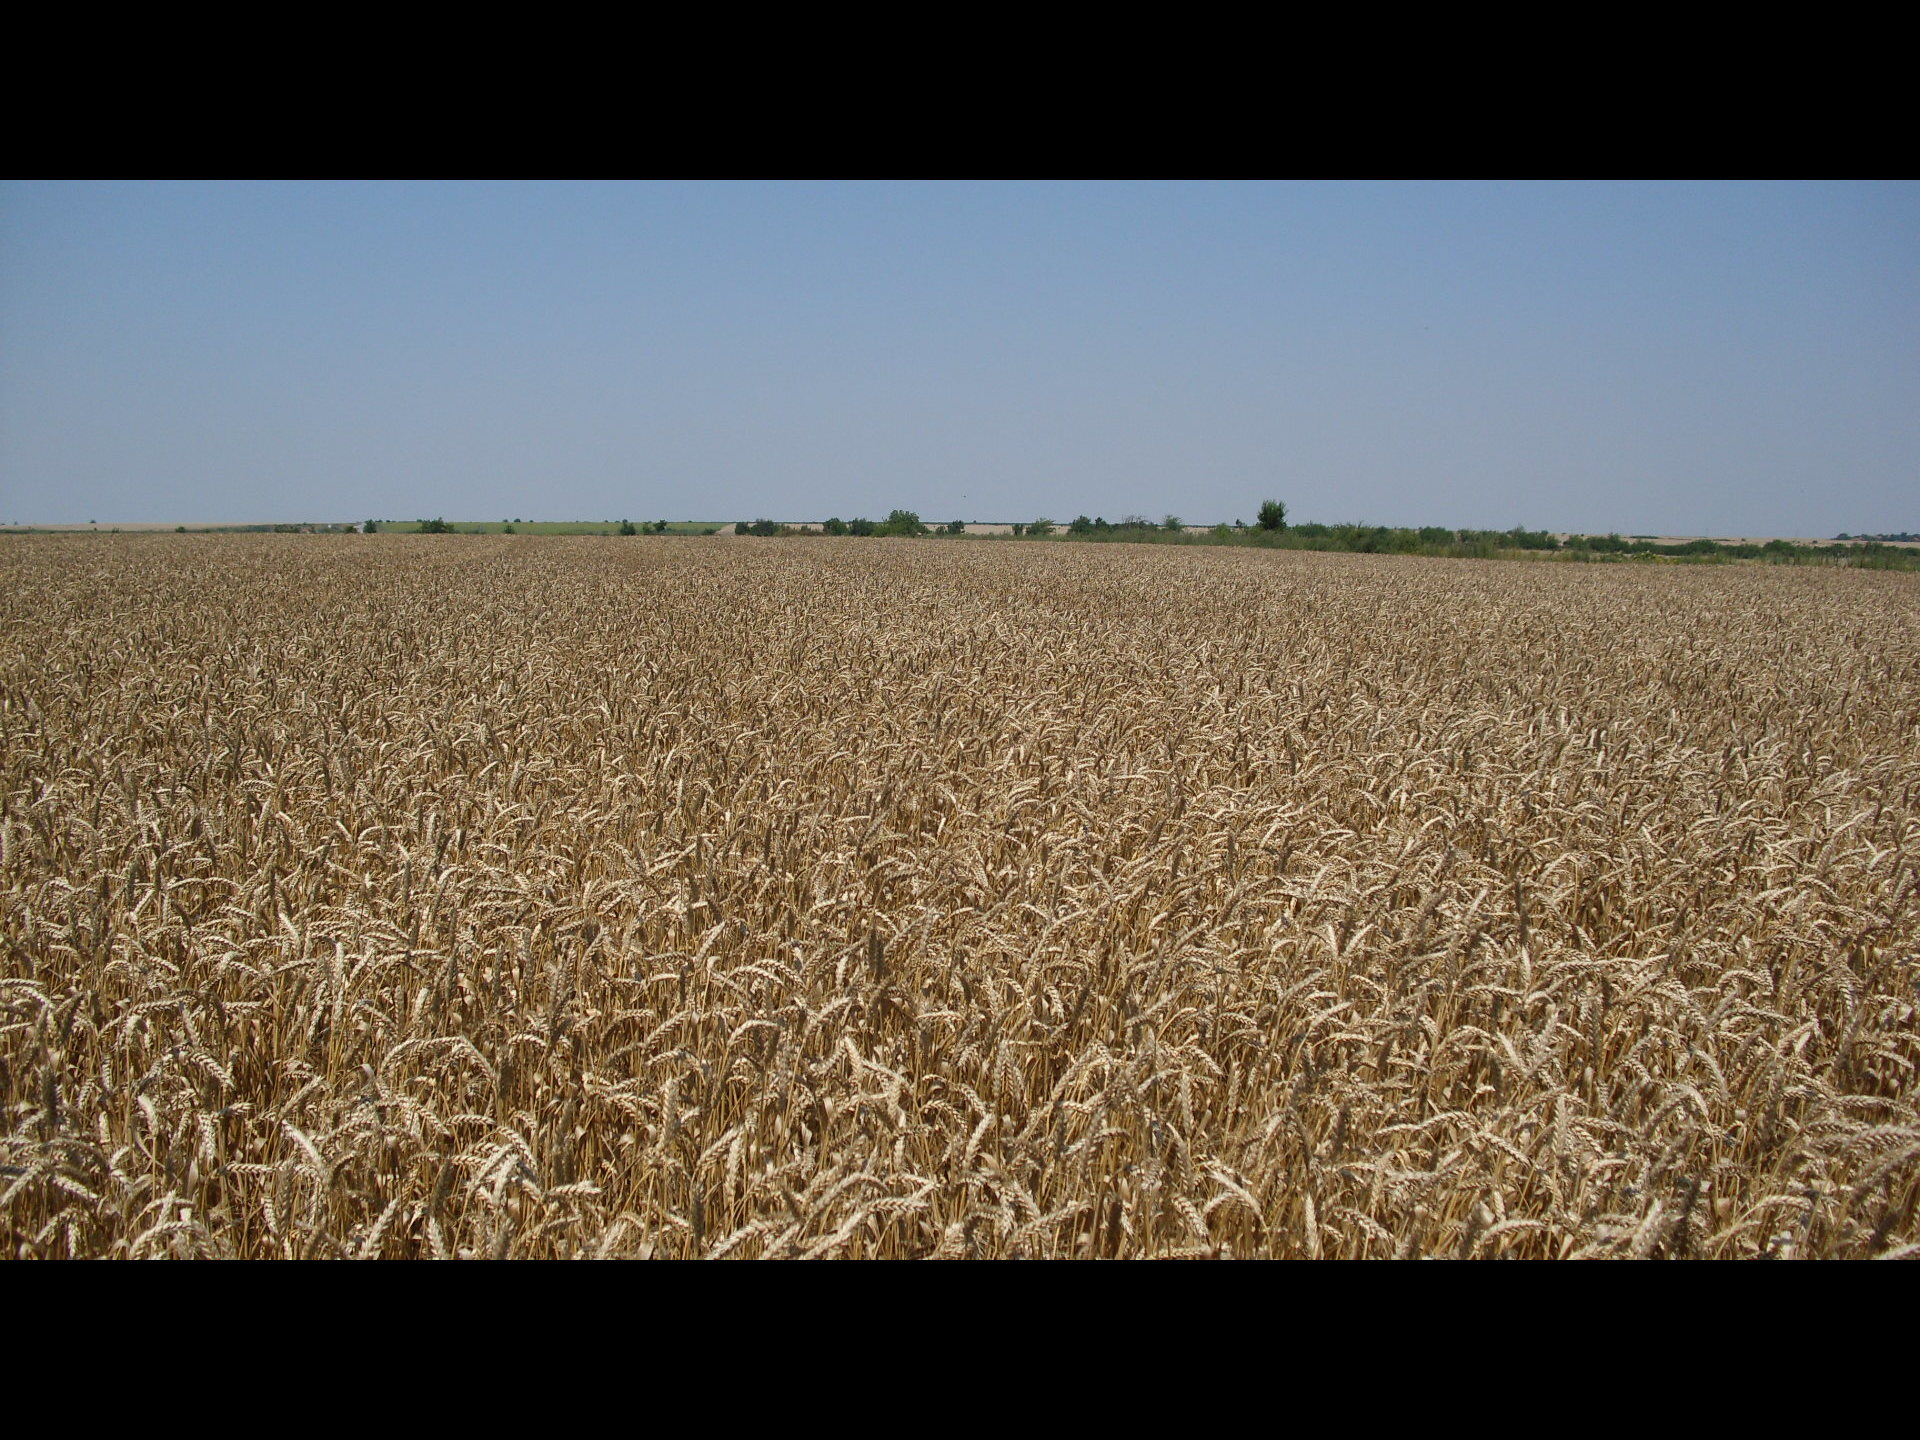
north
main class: Cropland
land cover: Common wheat
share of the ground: > 75 %
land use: Agriculture (excluding fallow land and kitchen gardens)
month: June
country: BG
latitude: 43.5870
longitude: 23.2568
